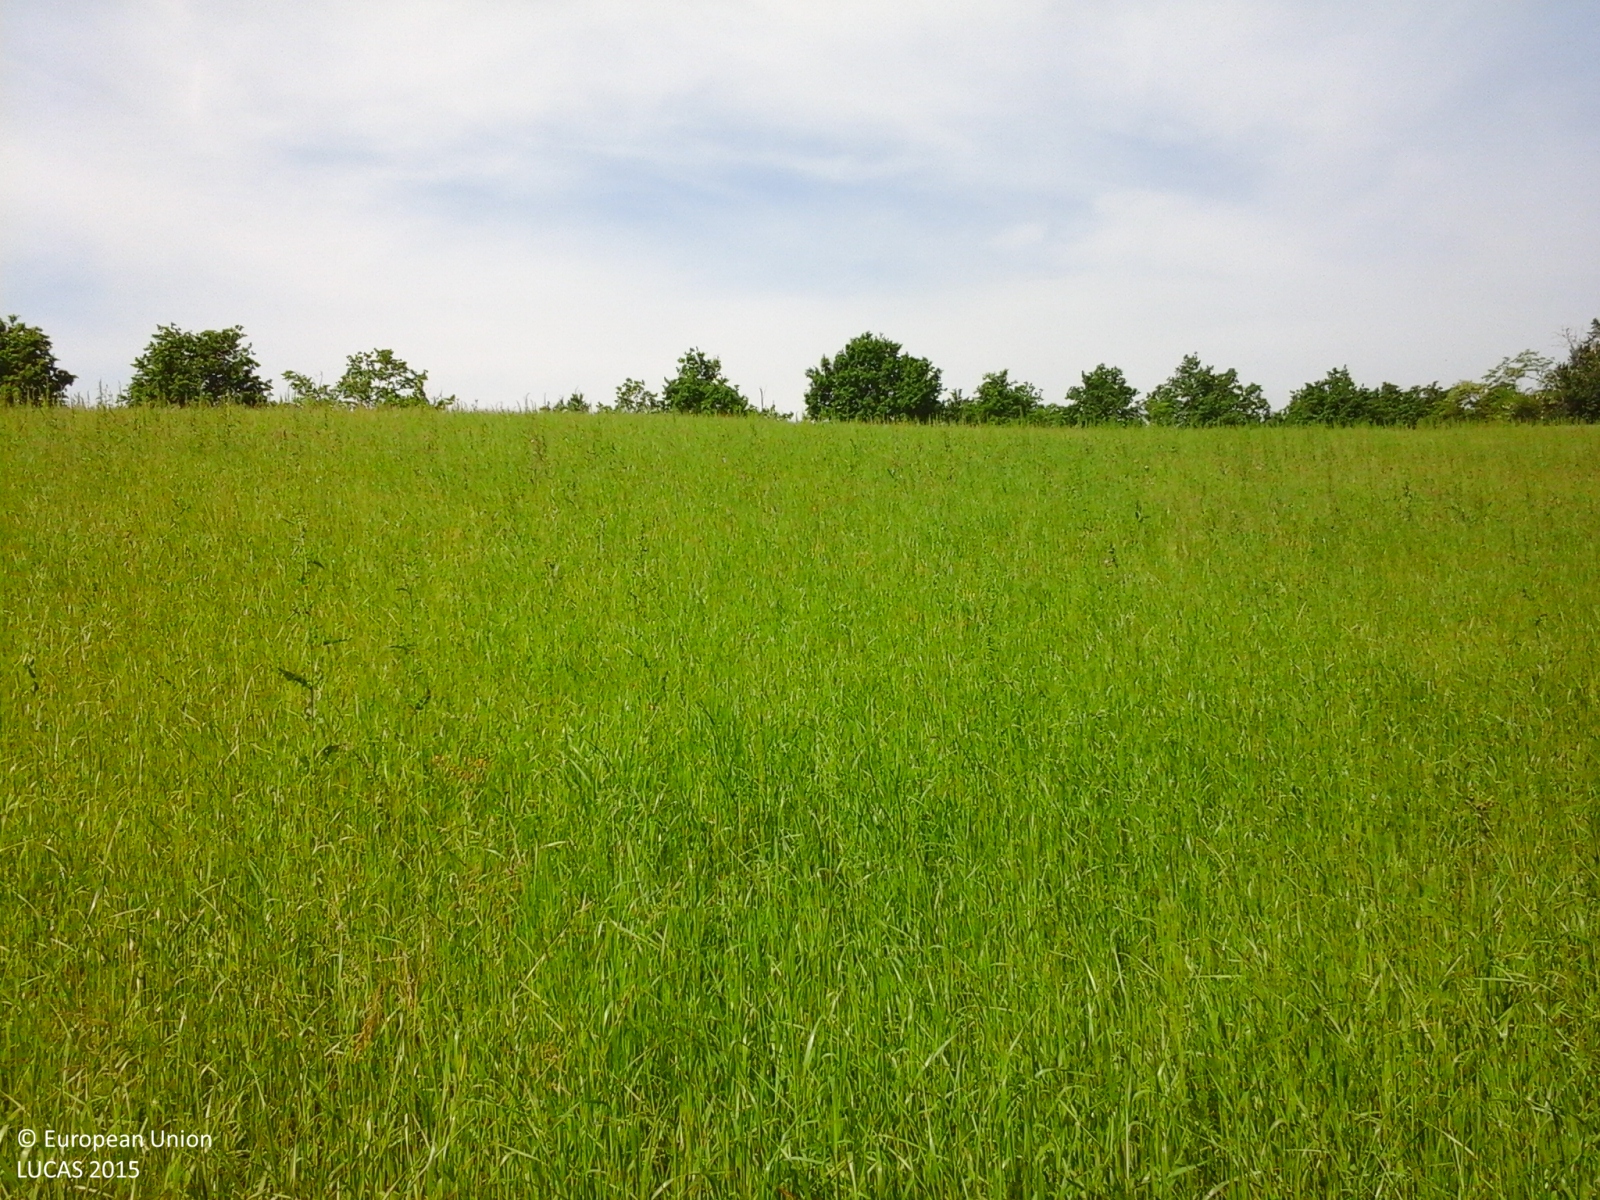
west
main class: Cropland
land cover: Temporary grasslands
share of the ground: > 75 %
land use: Agriculture (excluding fallow land and kitchen gardens)
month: May
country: IT
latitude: 44.9333
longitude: 8.3938
